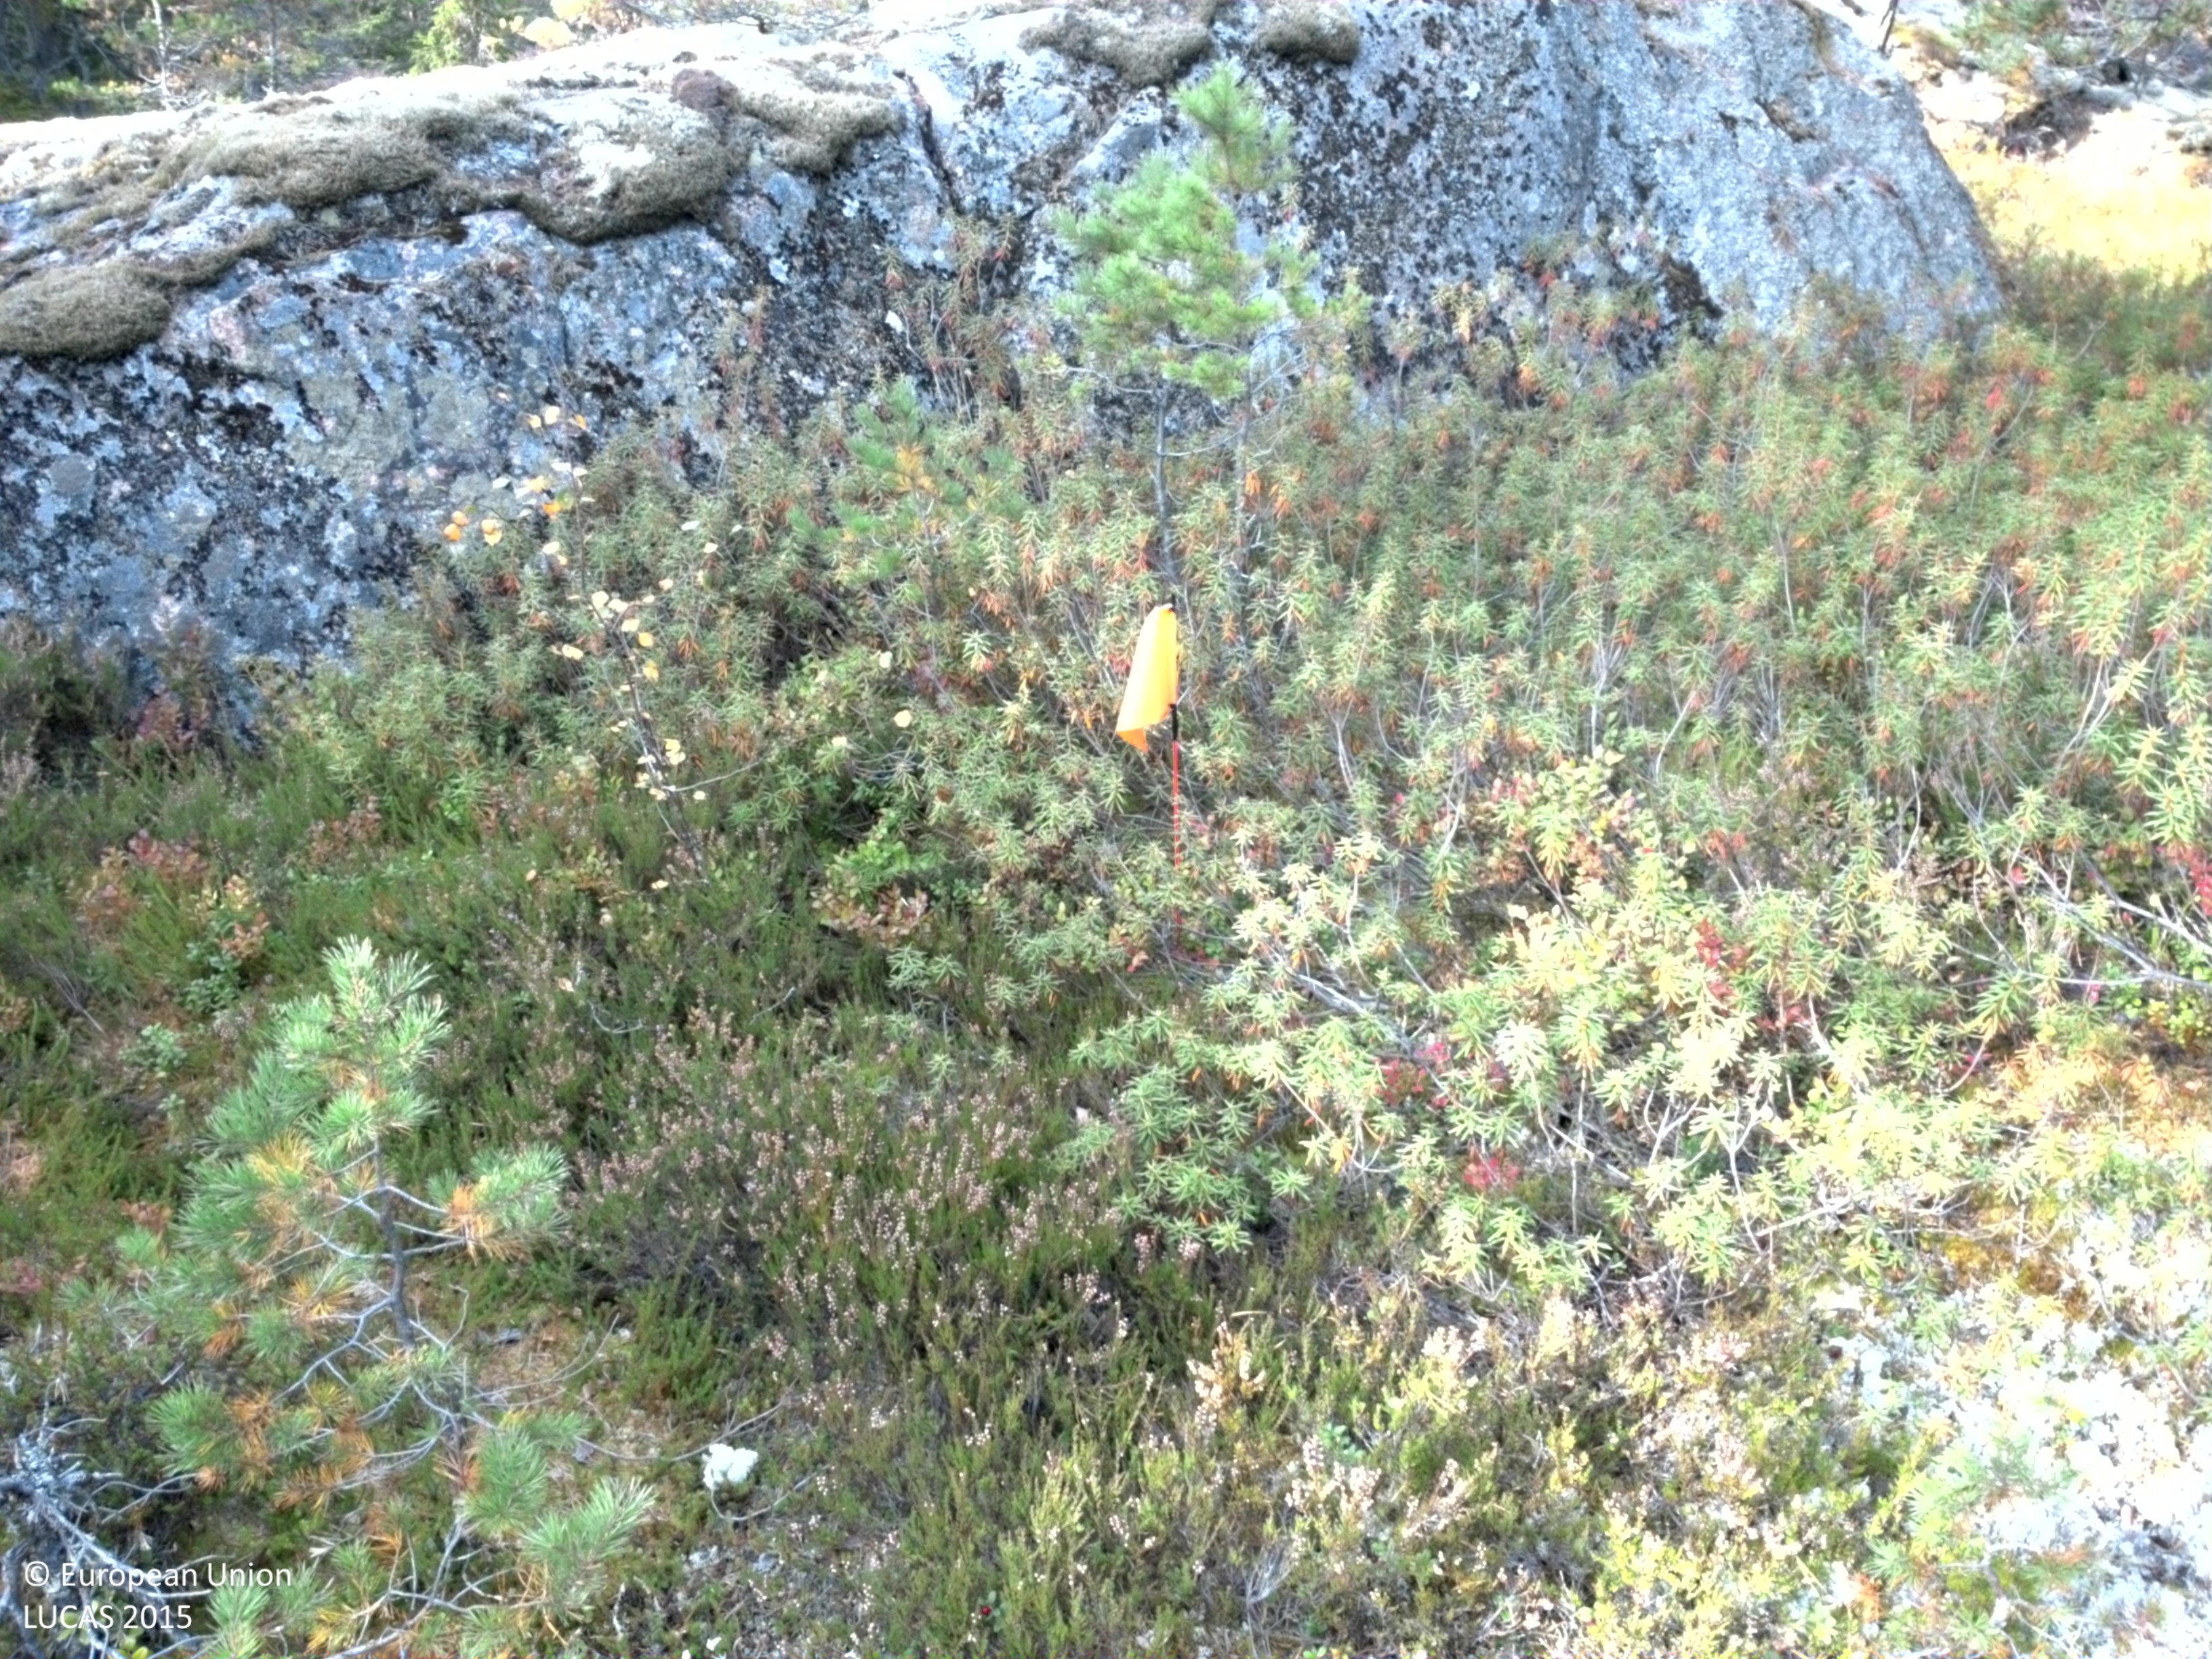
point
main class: Woodland
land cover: Pine dominated coniferous woodland
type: boreal forest
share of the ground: 50 - 75 %
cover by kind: coniferous forest trees 60 %, shrubs 20 %, consolidated bare surface 15 %, lichens and mosses 5 %
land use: Forestry
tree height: > 5 m
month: September
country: SE
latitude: 59.8131
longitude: 18.8262
